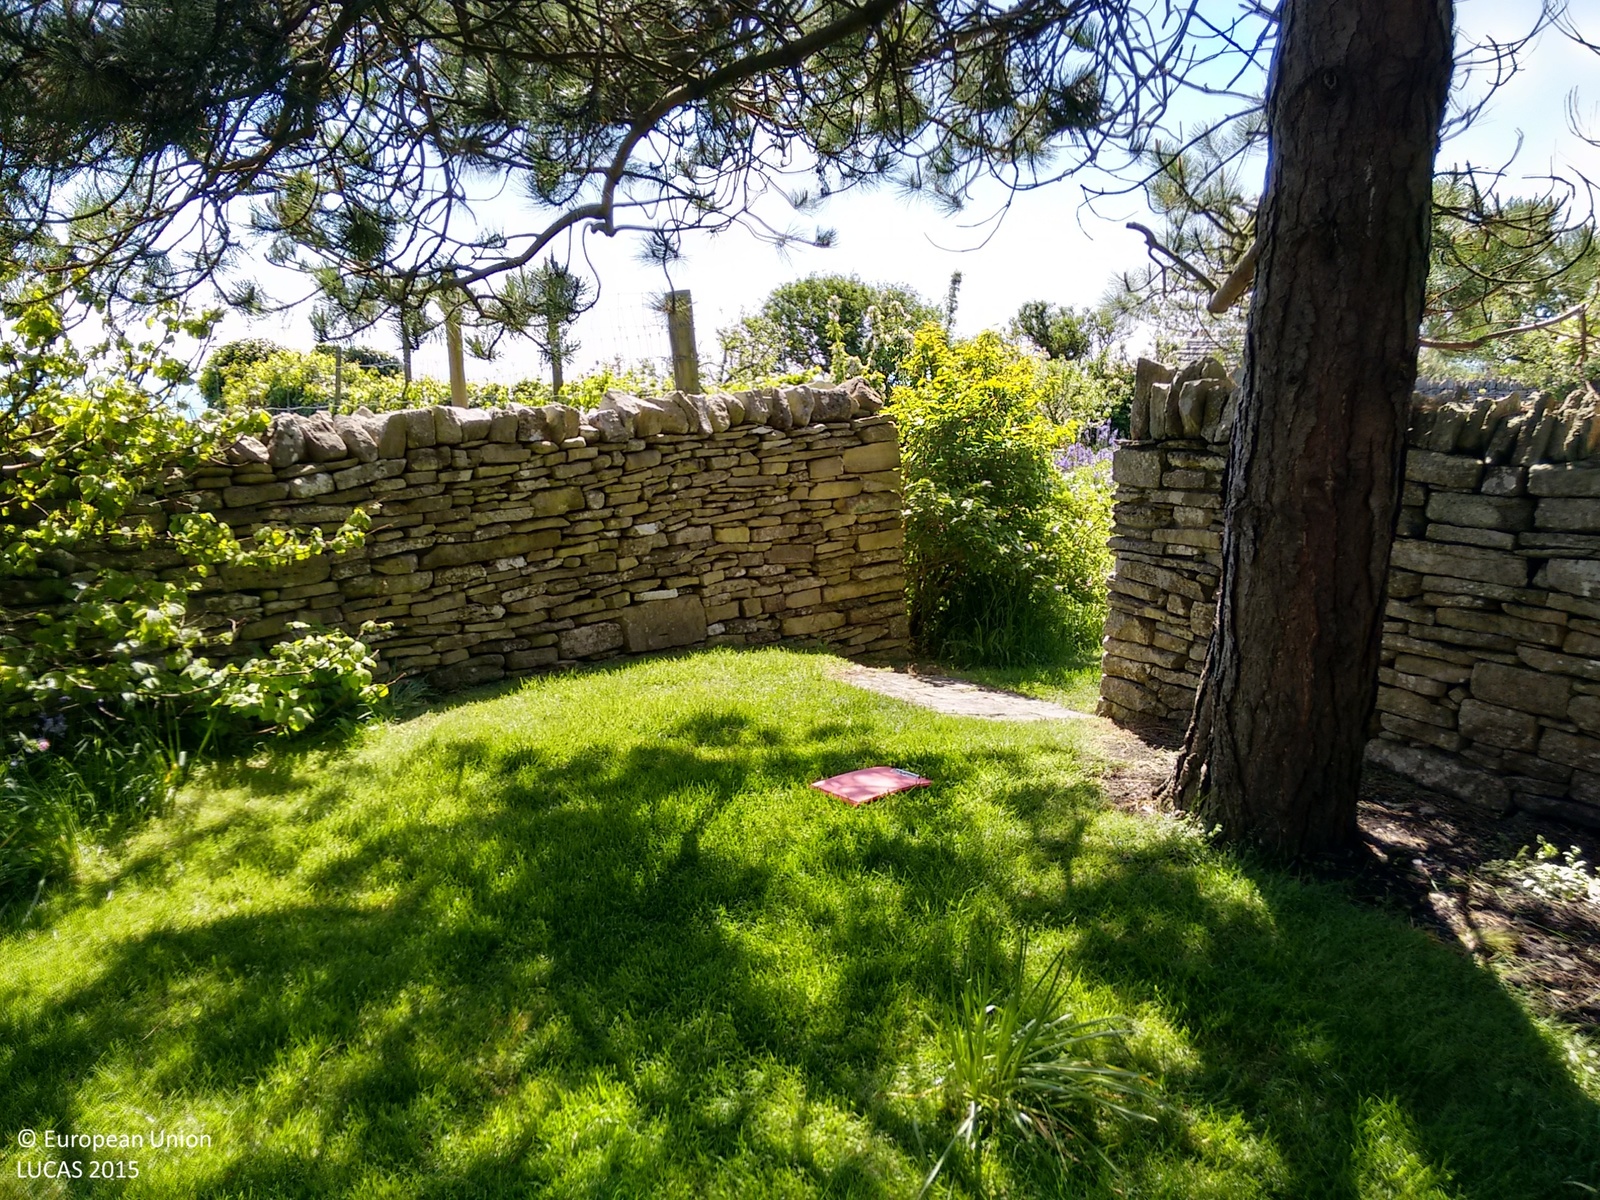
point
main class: Grassland
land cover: Grassland with sparse tree/shrub cover
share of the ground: > 75 %
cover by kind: herbaceous plants 90 %, coniferous forest trees 5 %, shrubs 5 %
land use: Residential
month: May
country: GB
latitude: 50.5997
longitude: -2.0250
